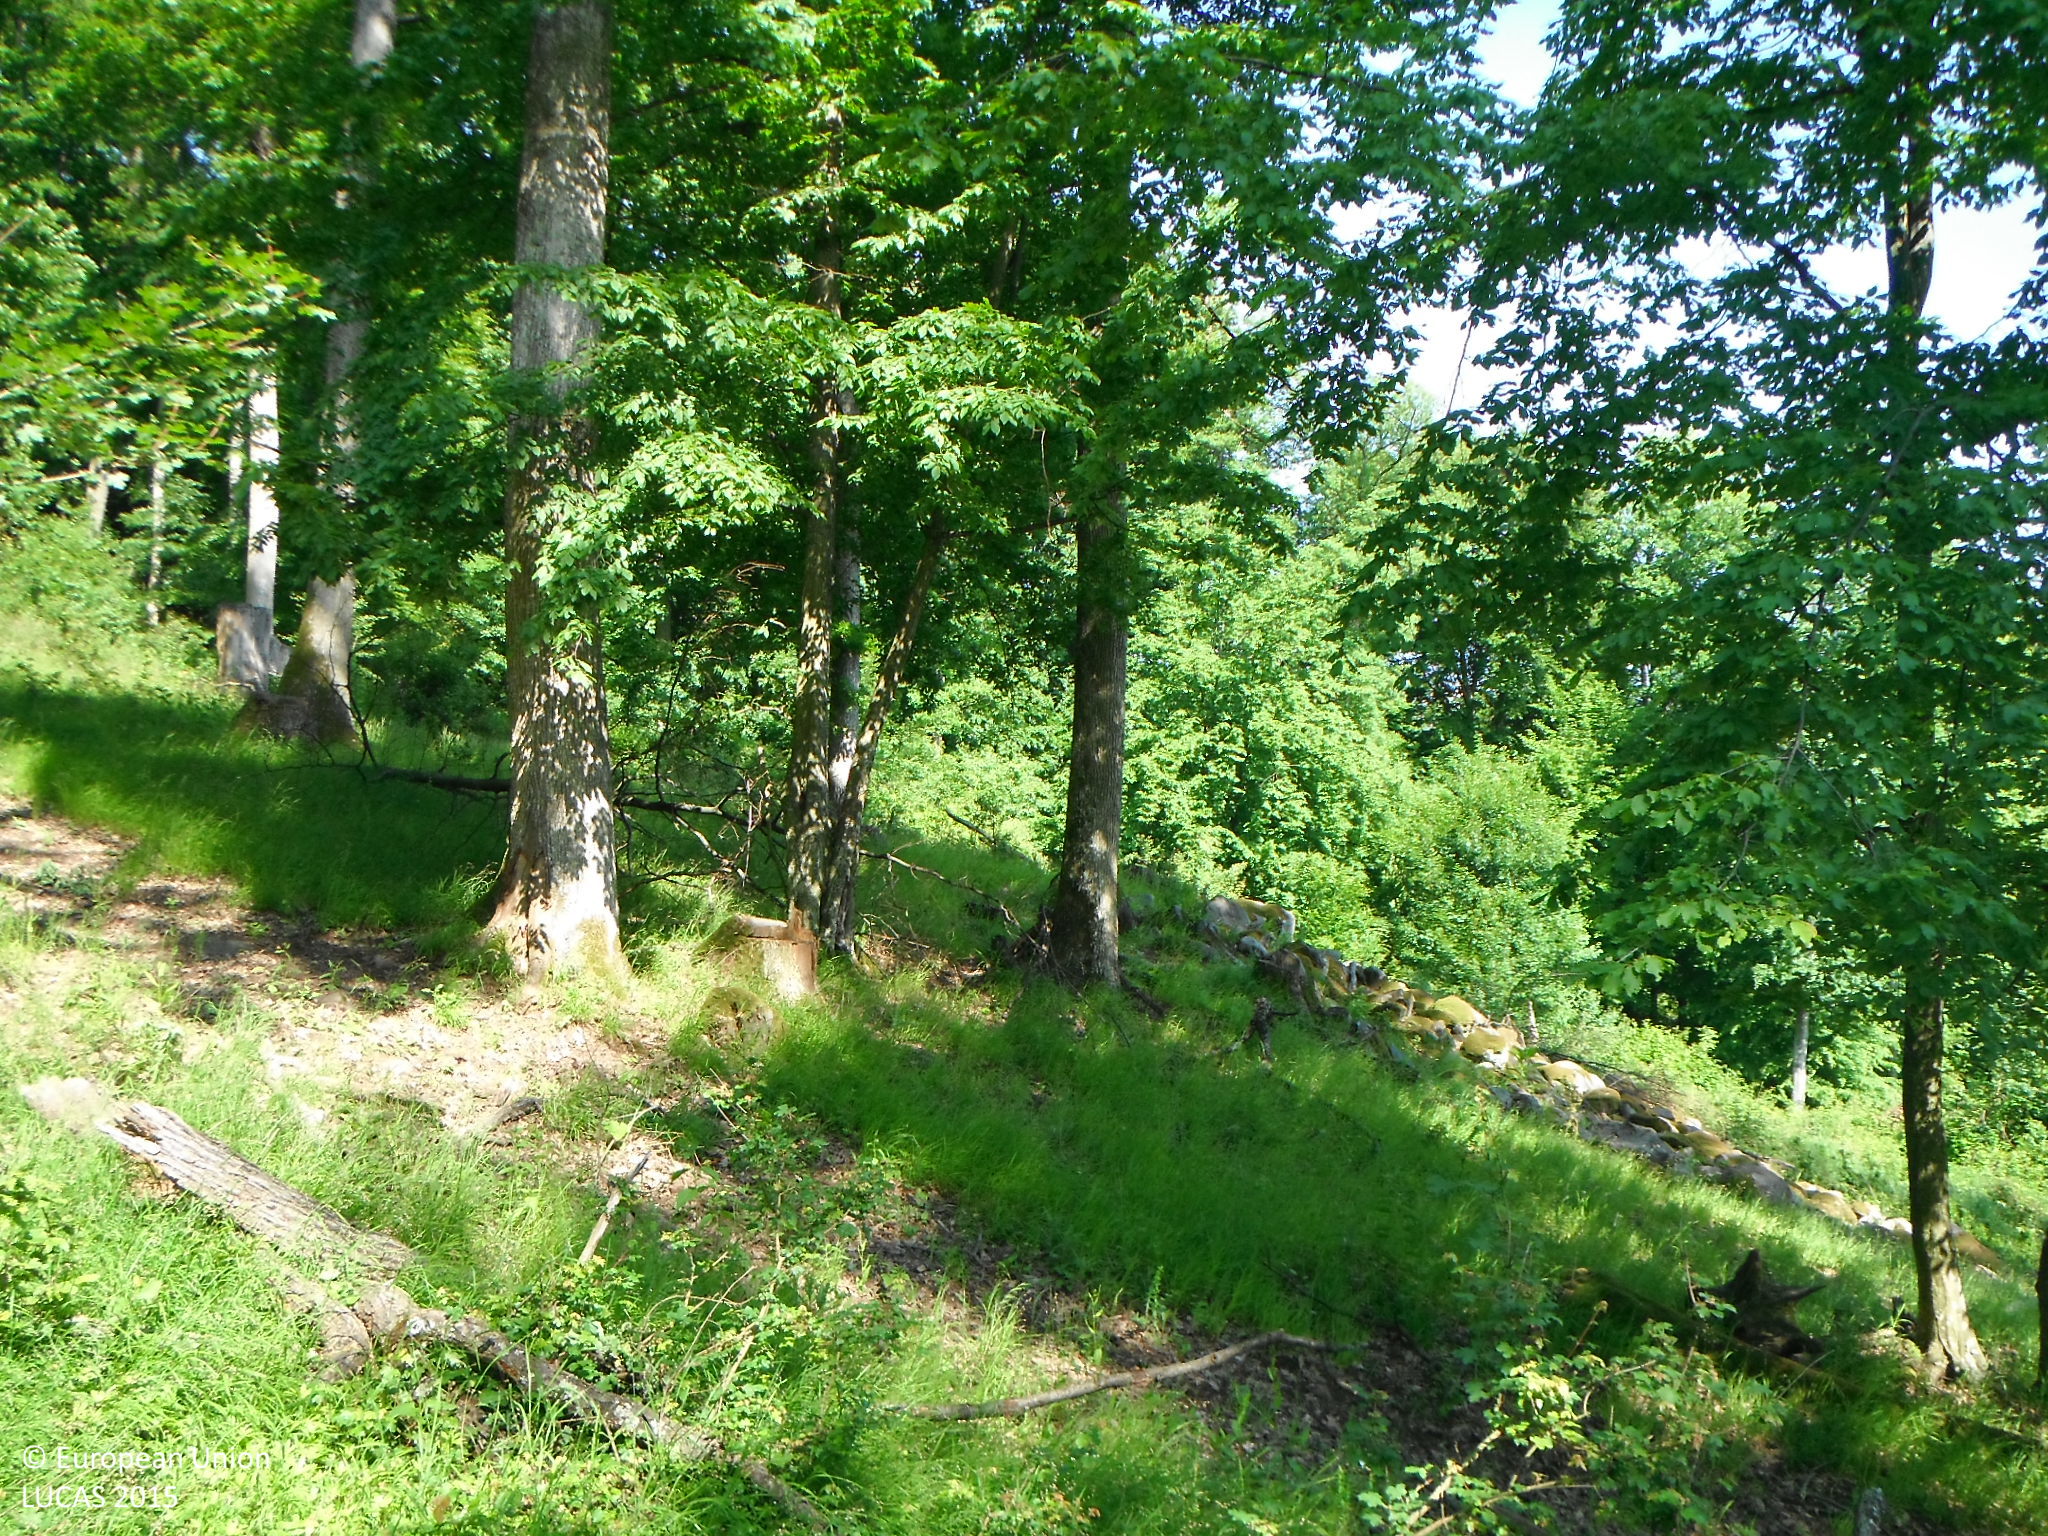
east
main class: Woodland
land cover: Broadleaved woodland
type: mesophytic deciduous forest
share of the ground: 50 - 75 %
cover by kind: broadleaved forest trees 75 %, herbaceous plants 25 %
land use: Forestry
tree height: > 5 m
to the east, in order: Broadleaved woodland; Spontaneously vegetated surfaces; Broadleaved woodland; Rocks and stones; Shrubland with sparse tree cover
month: May
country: SK
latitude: 48.3664
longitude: 18.9422
